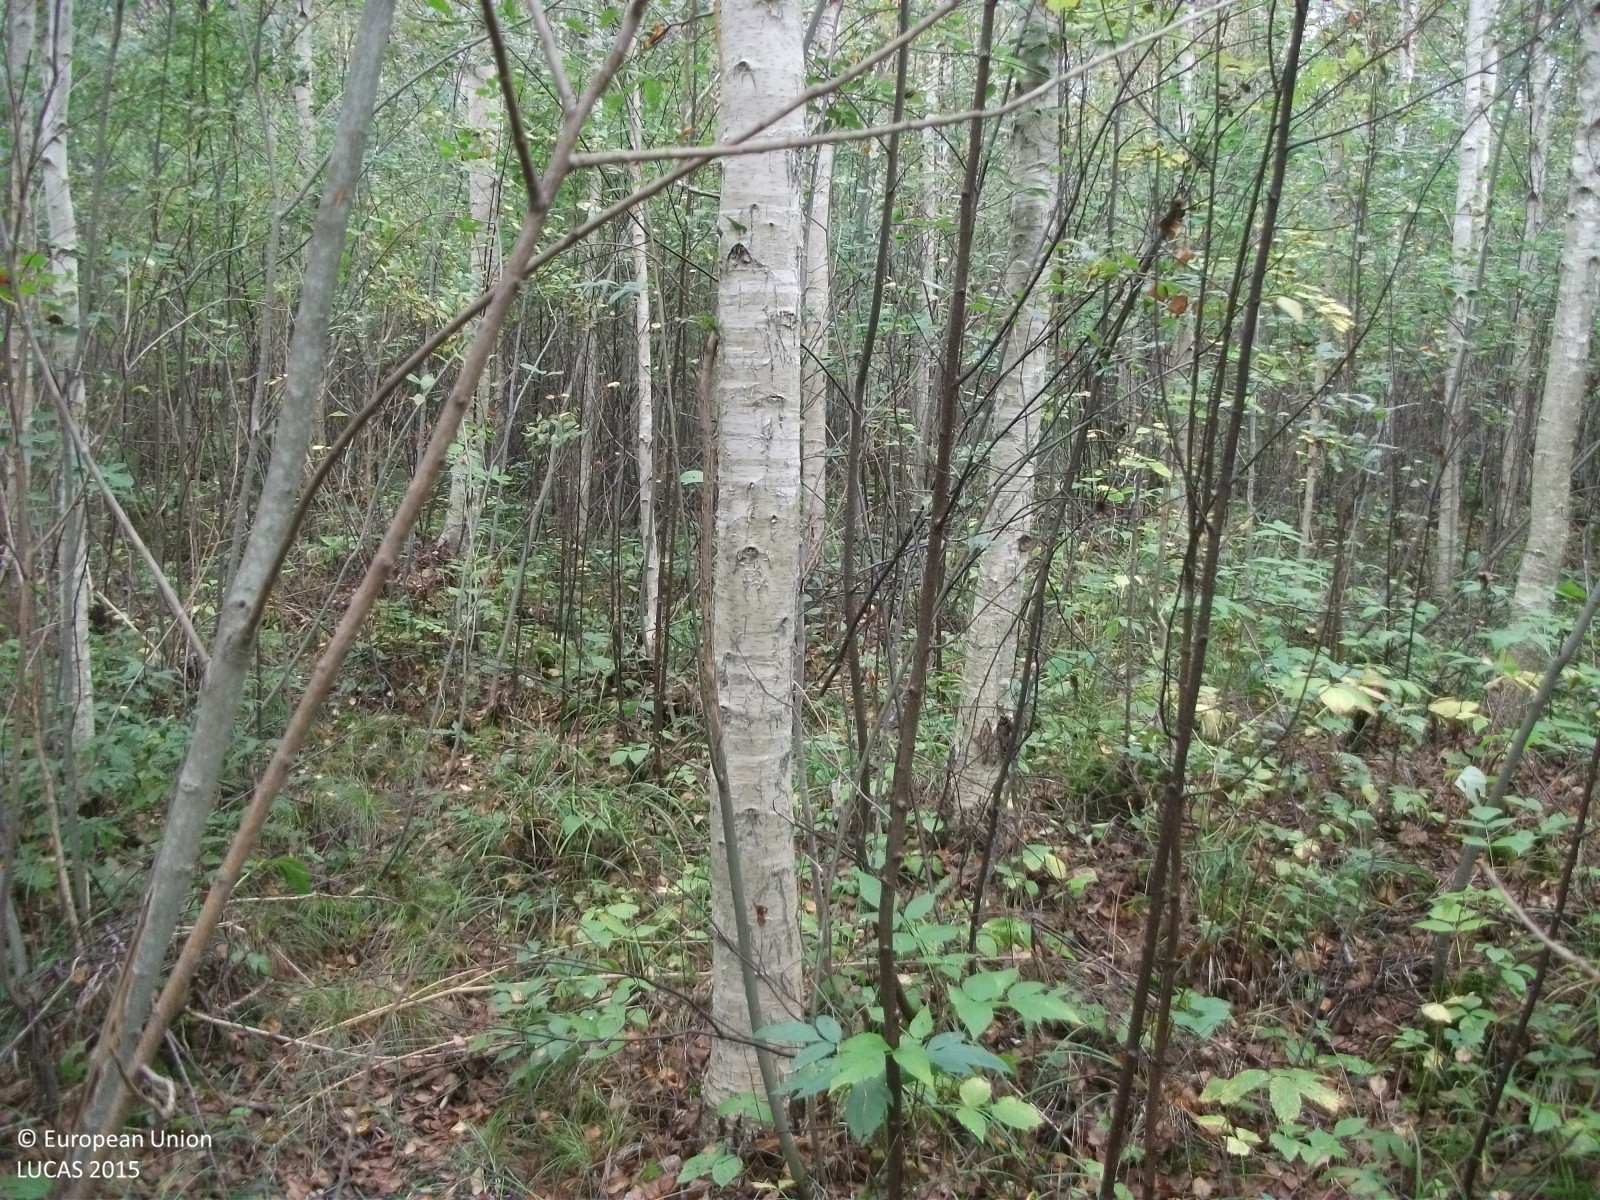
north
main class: Woodland
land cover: Broadleaved woodland
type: non-riverine alder, birch or aspen forest
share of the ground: > 75 %
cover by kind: broadleaved forest trees 90 %, shrubs 5 %, herbaceous plants 5 %
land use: Forestry
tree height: > 5 m
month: September
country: LV
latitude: 57.8074
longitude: 24.3743
